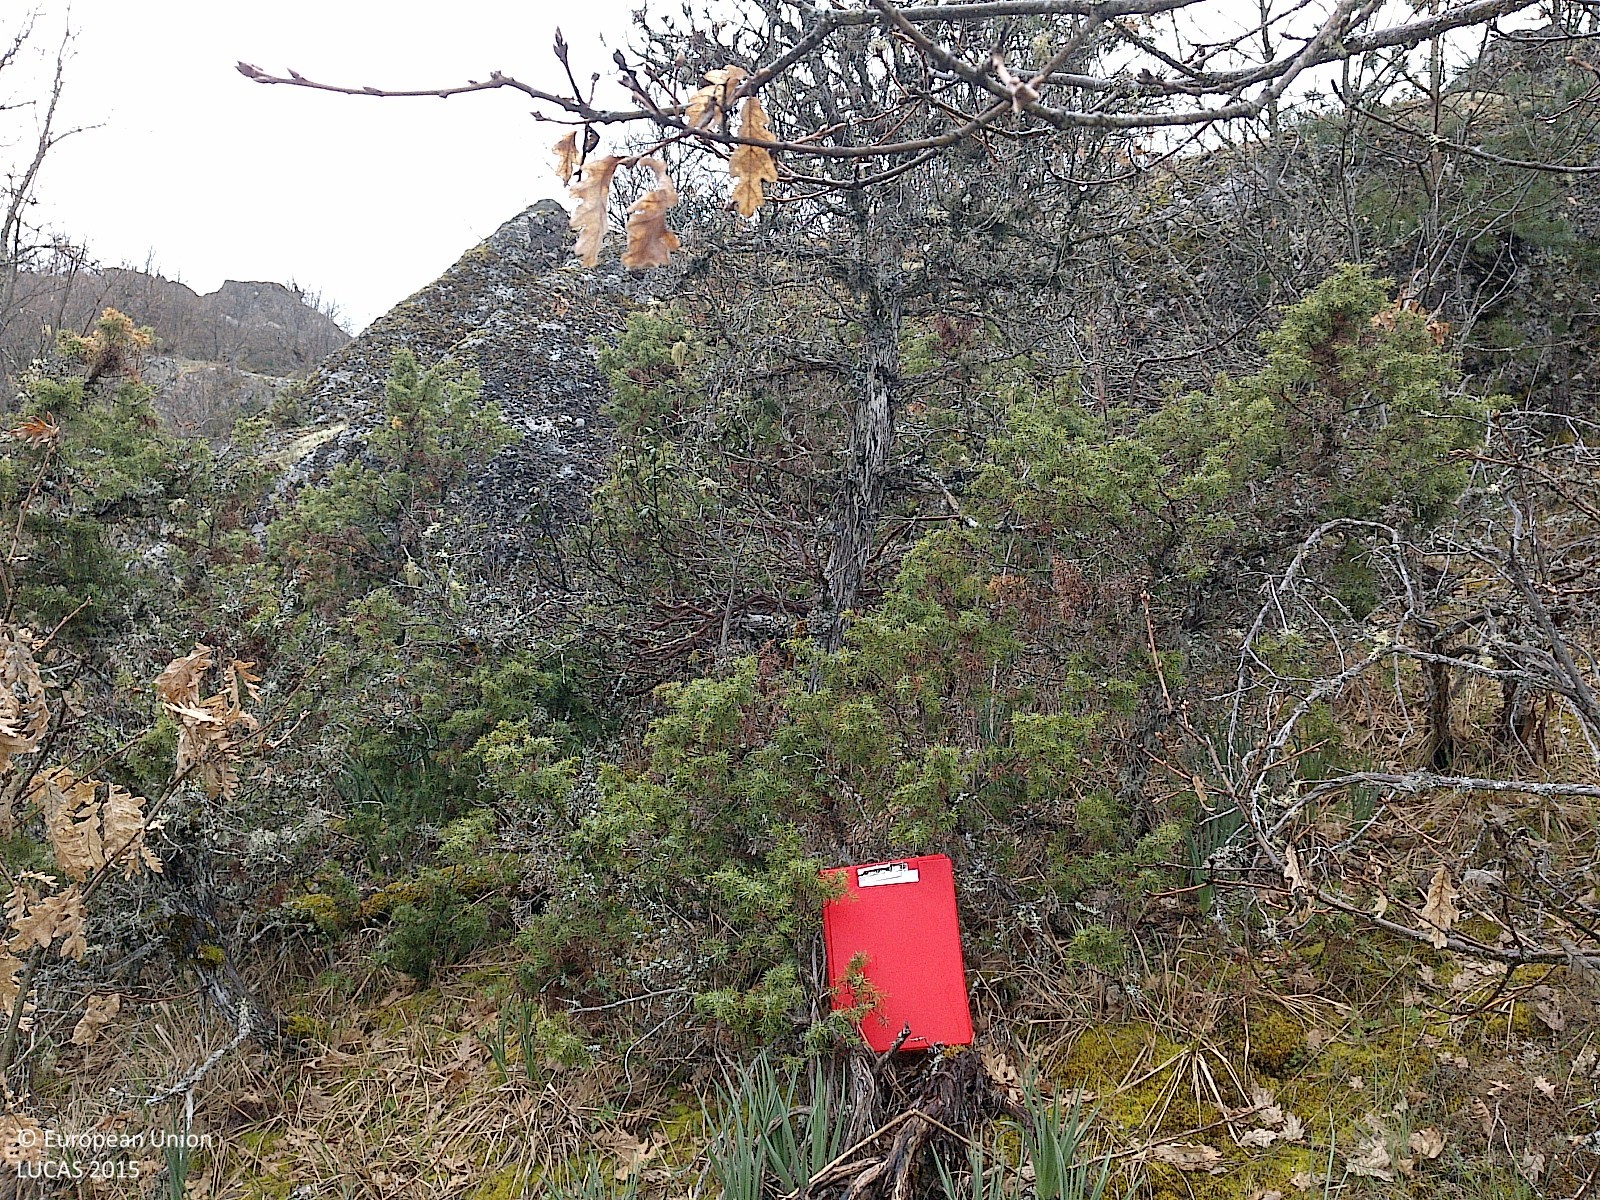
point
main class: Woodland
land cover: Broadleaved woodland
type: thermophilous deciduous forest
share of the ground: 25 - 50 %
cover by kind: shrubs 40 %, broadleaved forest trees 30 %, consolidated bare surface 15 %, herbaceous plants 10 %, coniferous forest trees 5 %
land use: Semi-natural and natural areas not in use
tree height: < 5 m
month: May
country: ES
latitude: 41.9345
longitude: -3.1825
